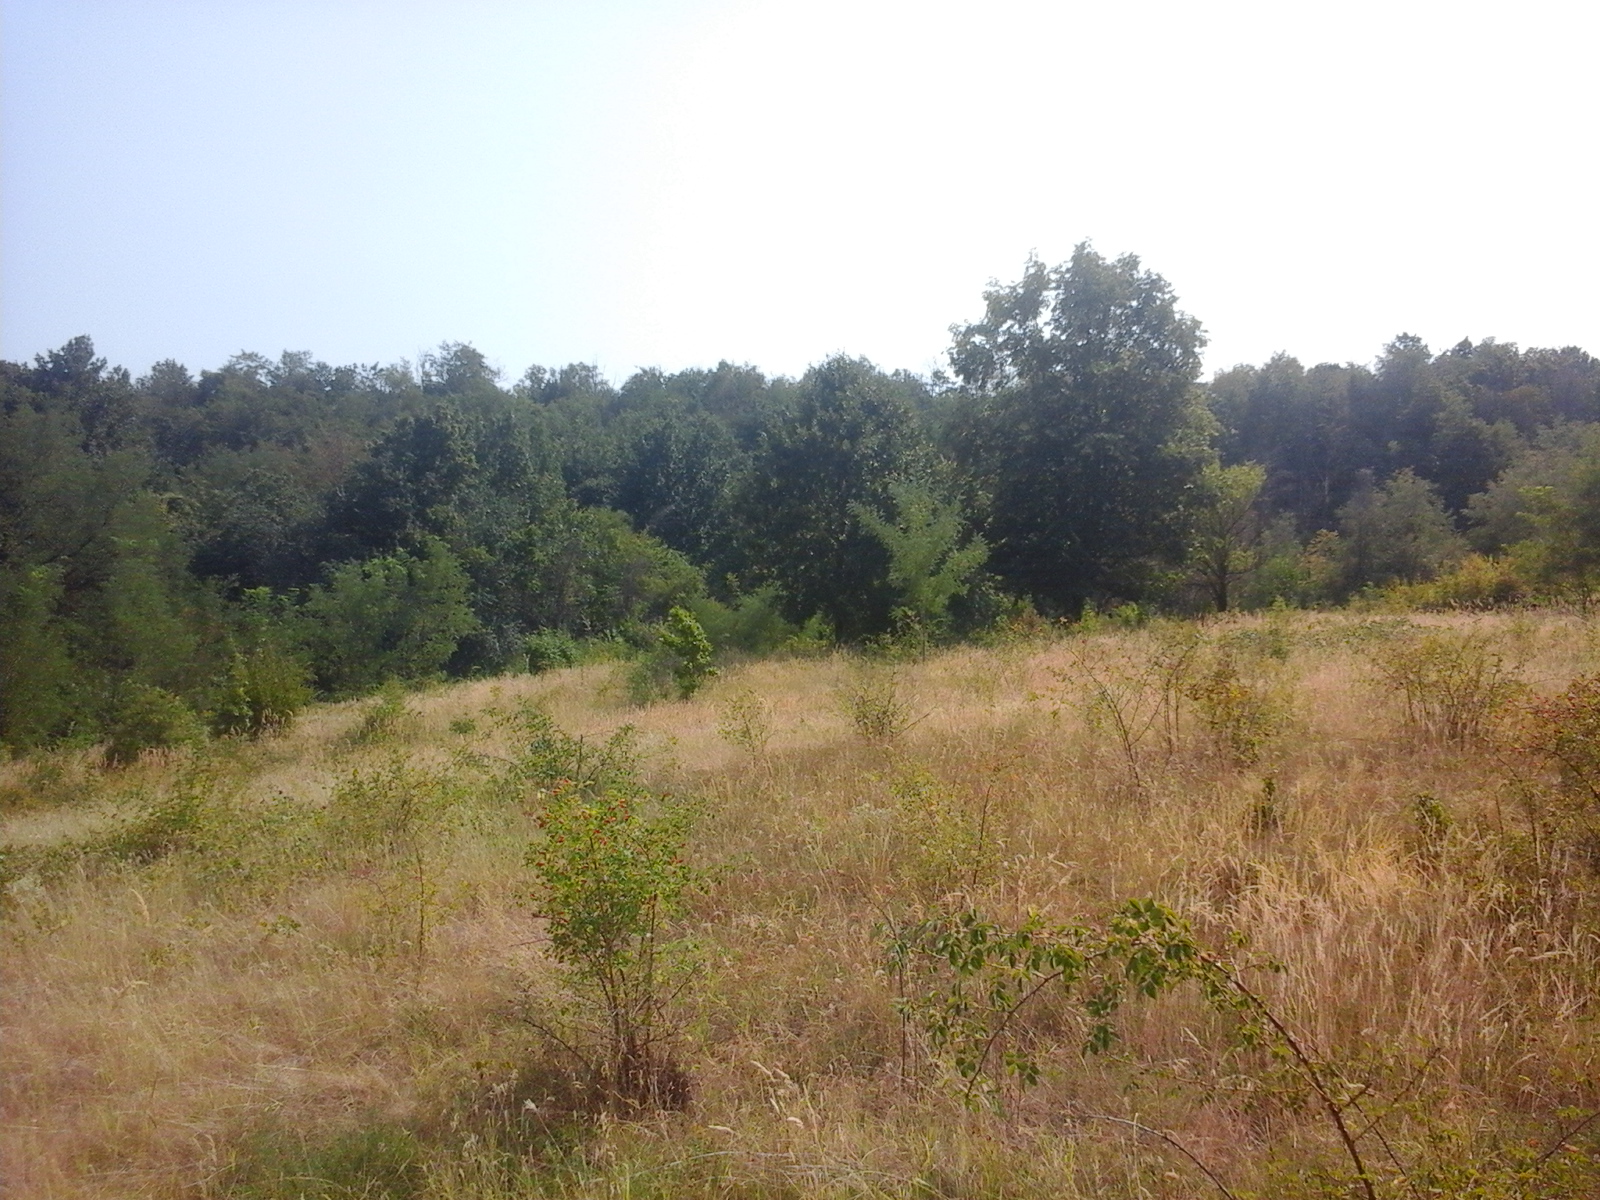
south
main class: Grassland
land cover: Grassland with sparse tree/shrub cover
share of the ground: > 75 %
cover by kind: herbaceous plants 85 %, shrubs 10 %, broadleaved forest trees 5 %
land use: Agriculture (excluding fallow land and kitchen gardens)
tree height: < 5 m
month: August
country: RO
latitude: 44.4962
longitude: 22.7053
